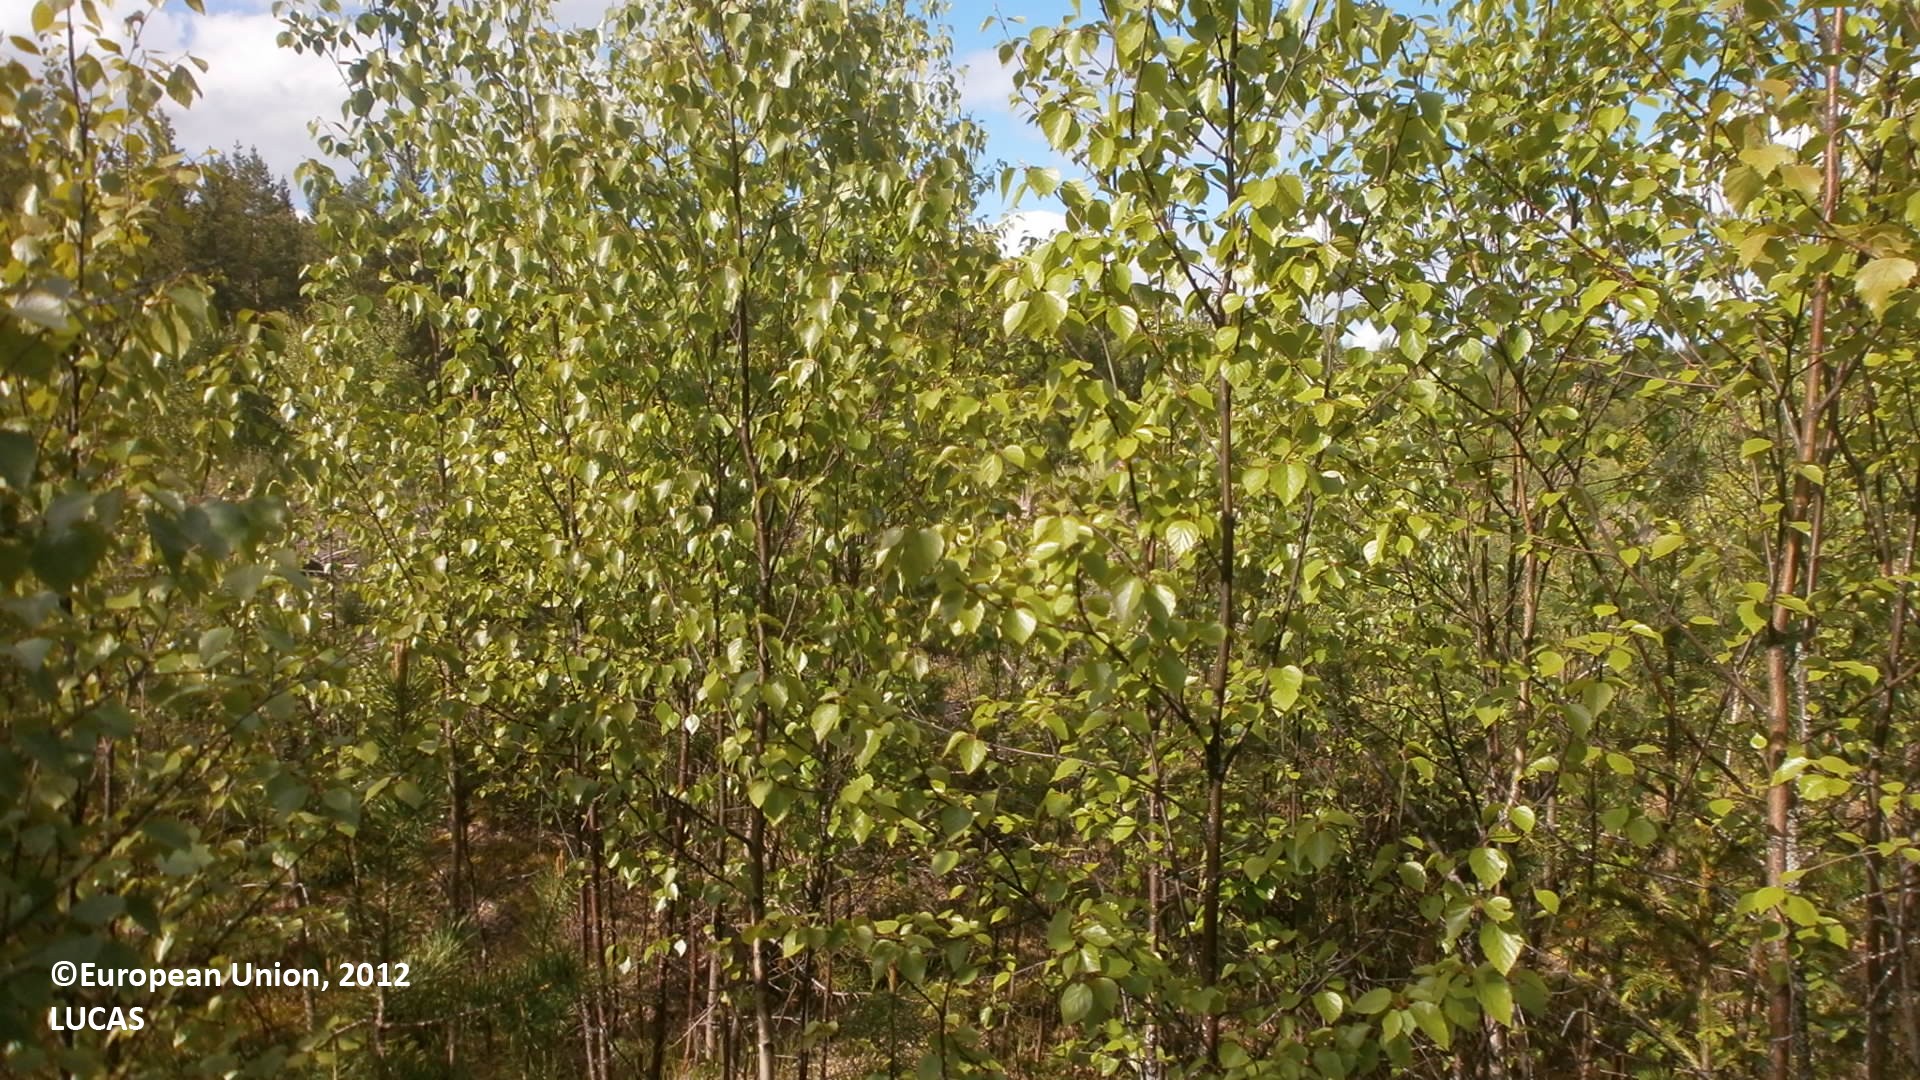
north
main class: Woodland
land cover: Other mixed woodland
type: mire and swamp forests
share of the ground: > 75 %
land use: Forestry
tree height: < 5 m
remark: Clear cut
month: June
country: FI
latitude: 64.5112
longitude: 25.1824
